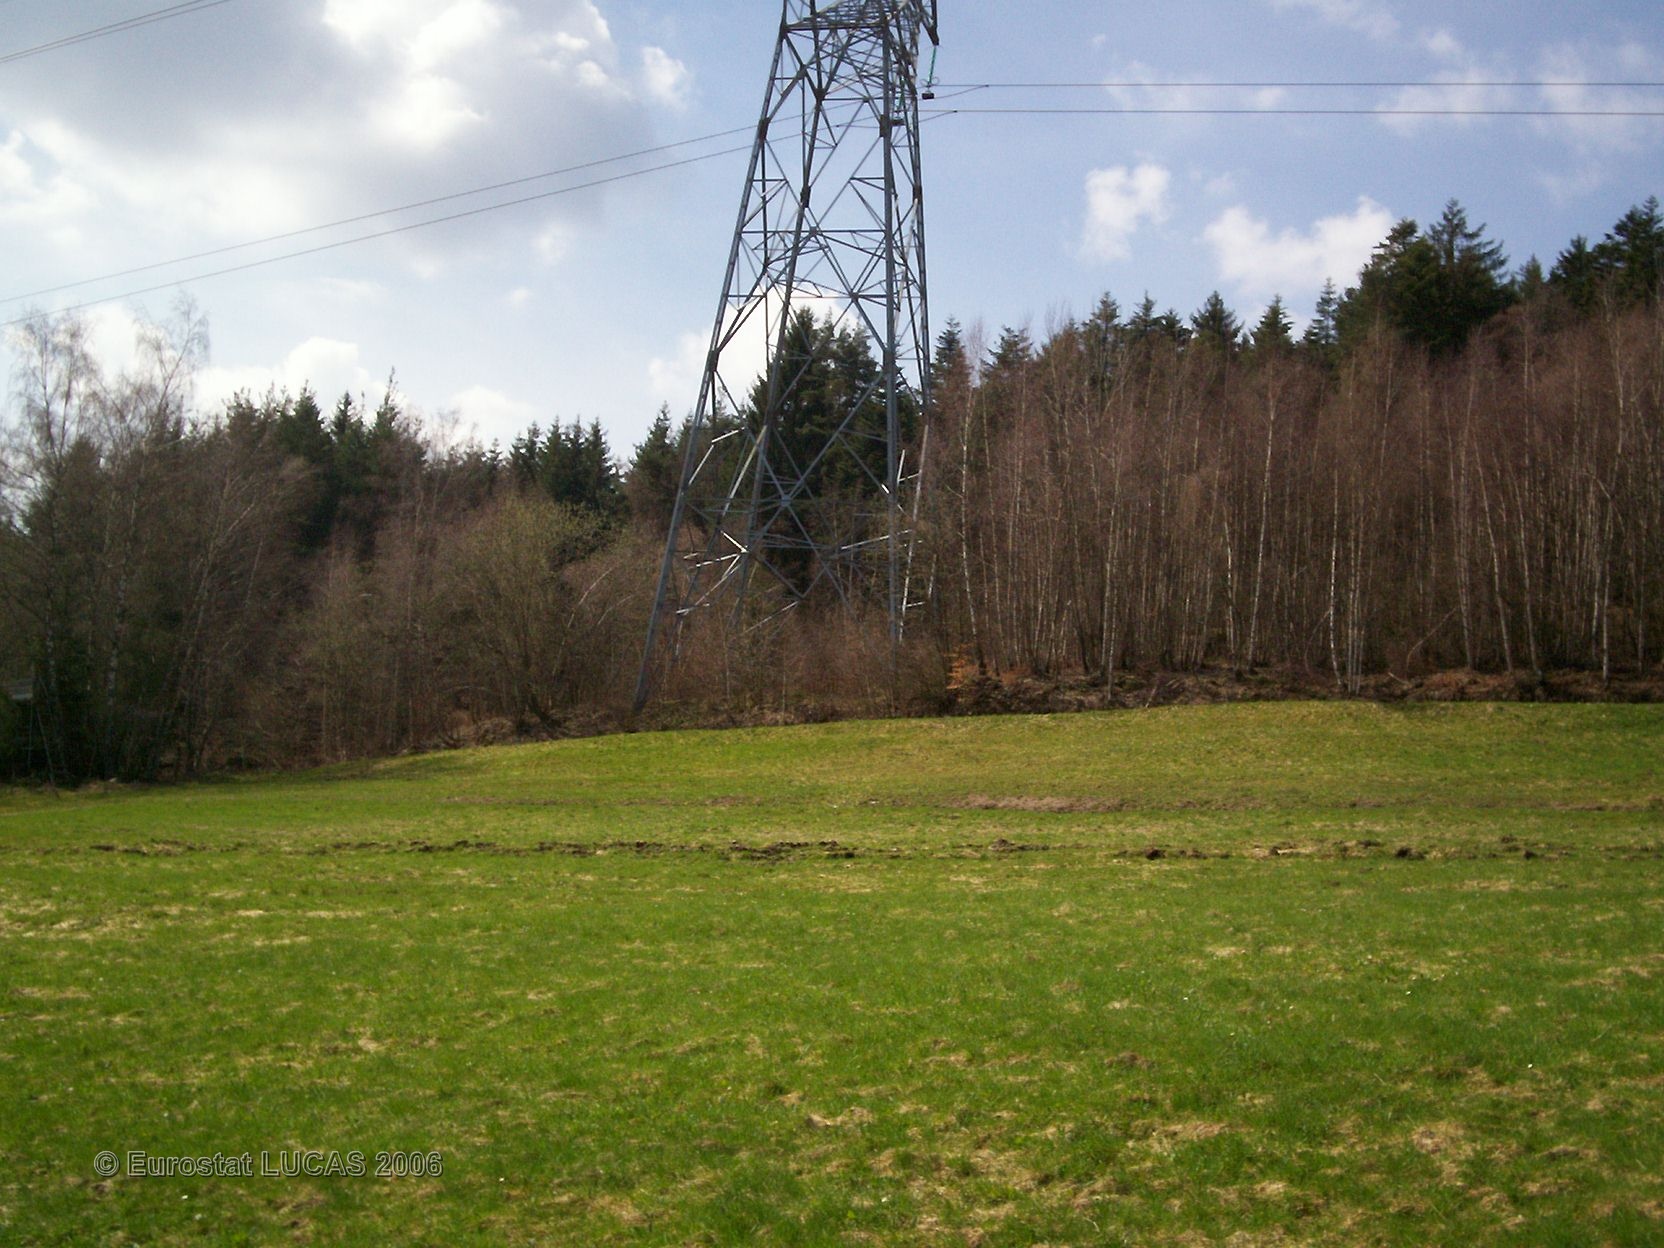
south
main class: Grassland
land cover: Grassland without tree/shrub cover
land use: Agriculture (excluding fallow land and kitchen gardens)
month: April
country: FR
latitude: 48.1144
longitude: 7.1400
